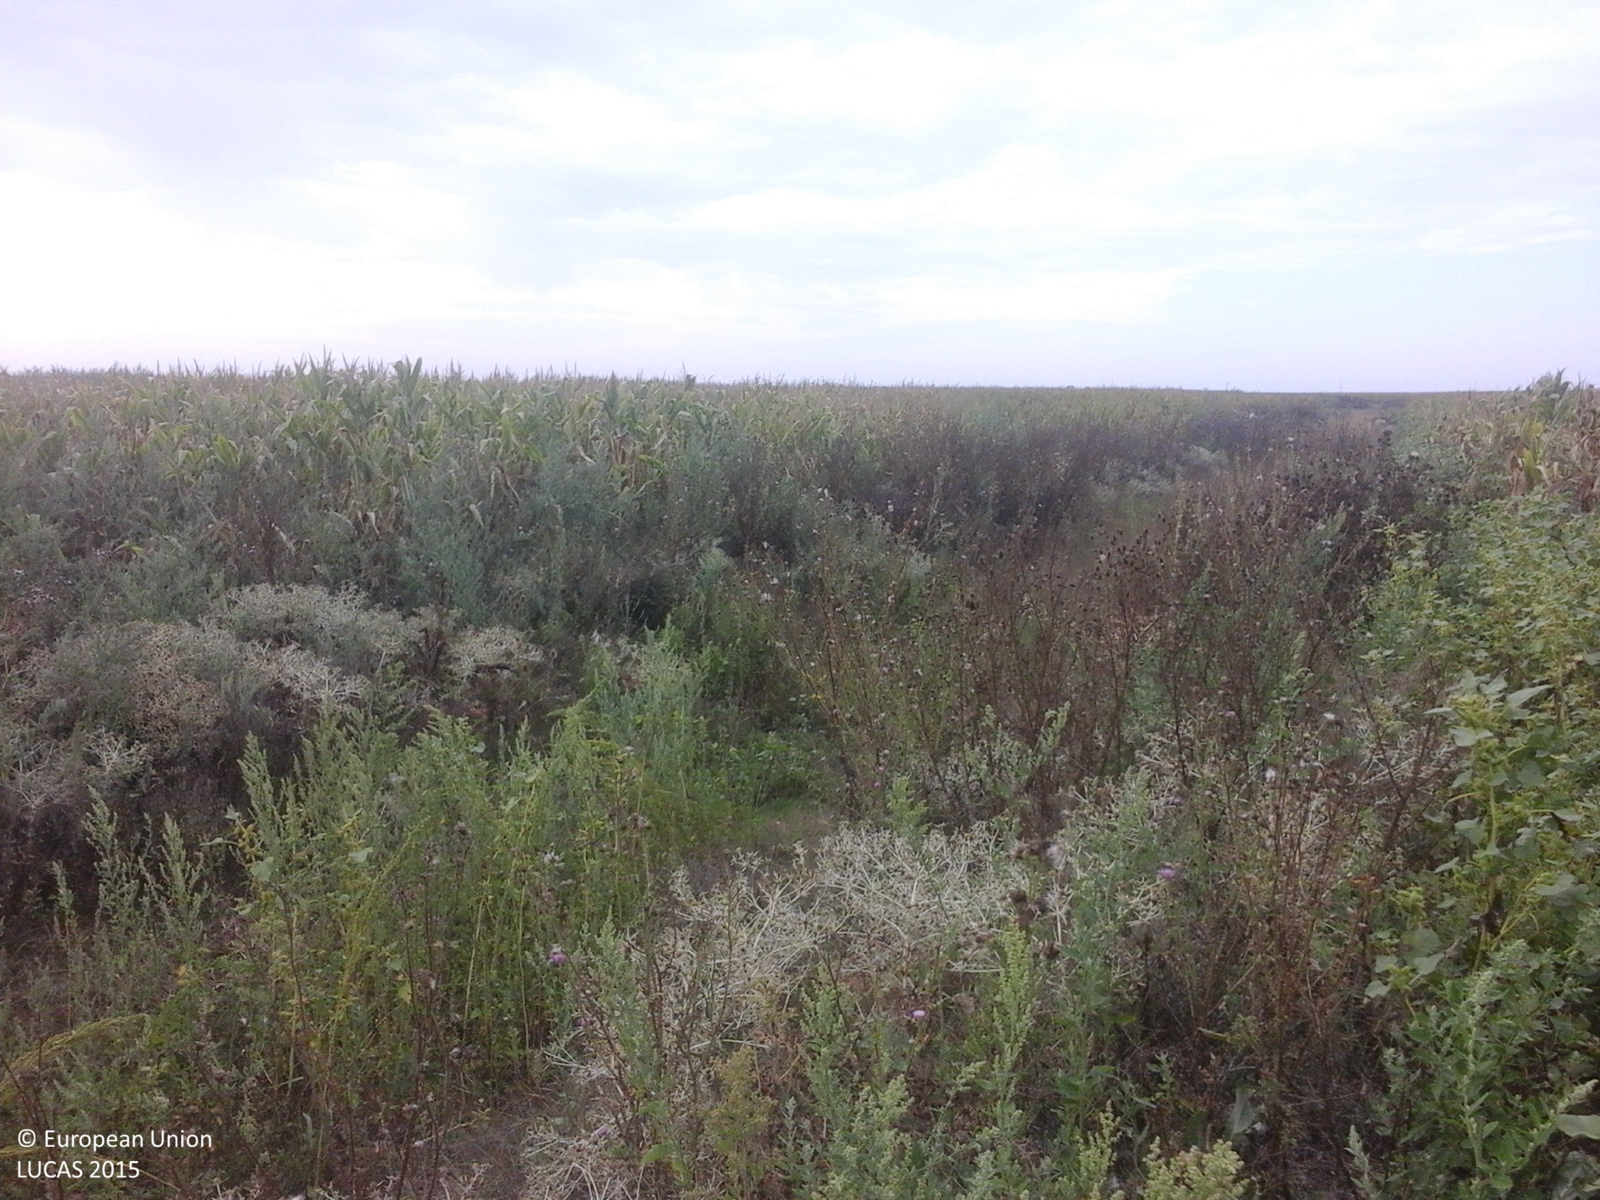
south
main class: Cropland
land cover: Maize
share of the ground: > 75 %
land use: Agriculture (excluding fallow land and kitchen gardens)
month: August
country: RO
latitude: 46.3364
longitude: 21.4295
